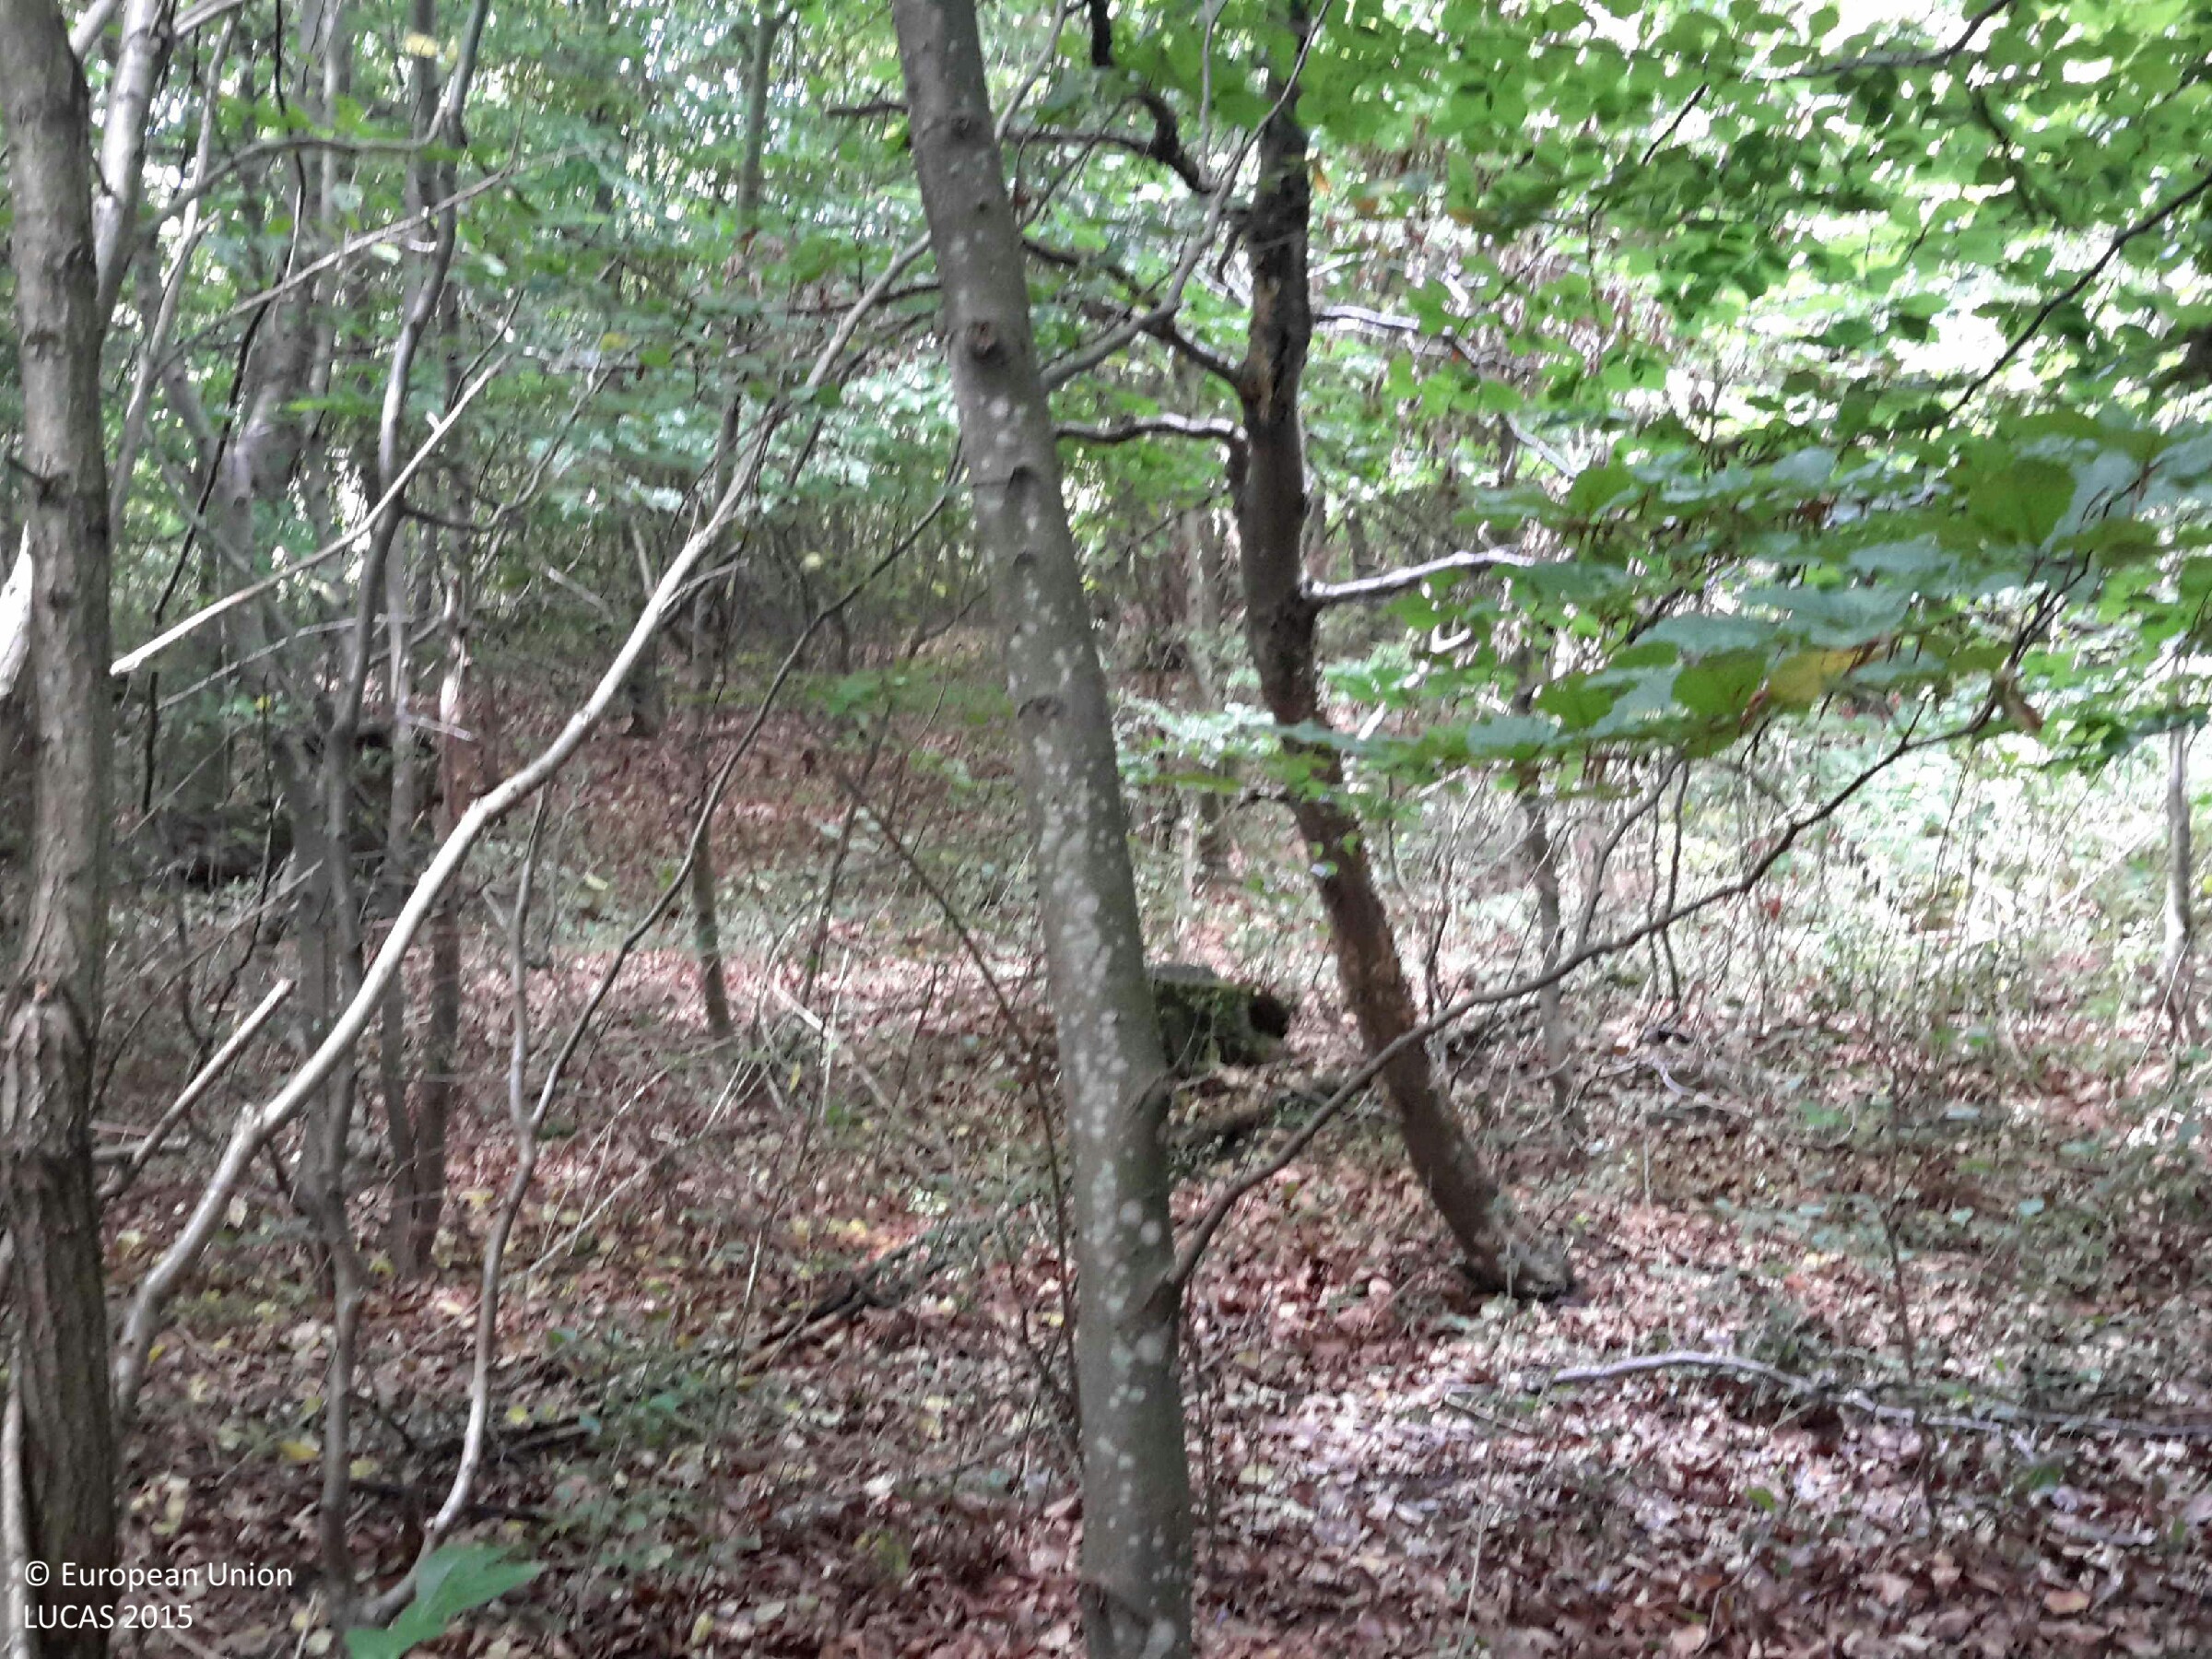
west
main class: Woodland
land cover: Broadleaved woodland
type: beech forest
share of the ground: > 75 %
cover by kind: broadleaved forest trees 100 %
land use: Forestry
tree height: > 5 m
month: July
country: HU
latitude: 47.1810
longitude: 16.5350
